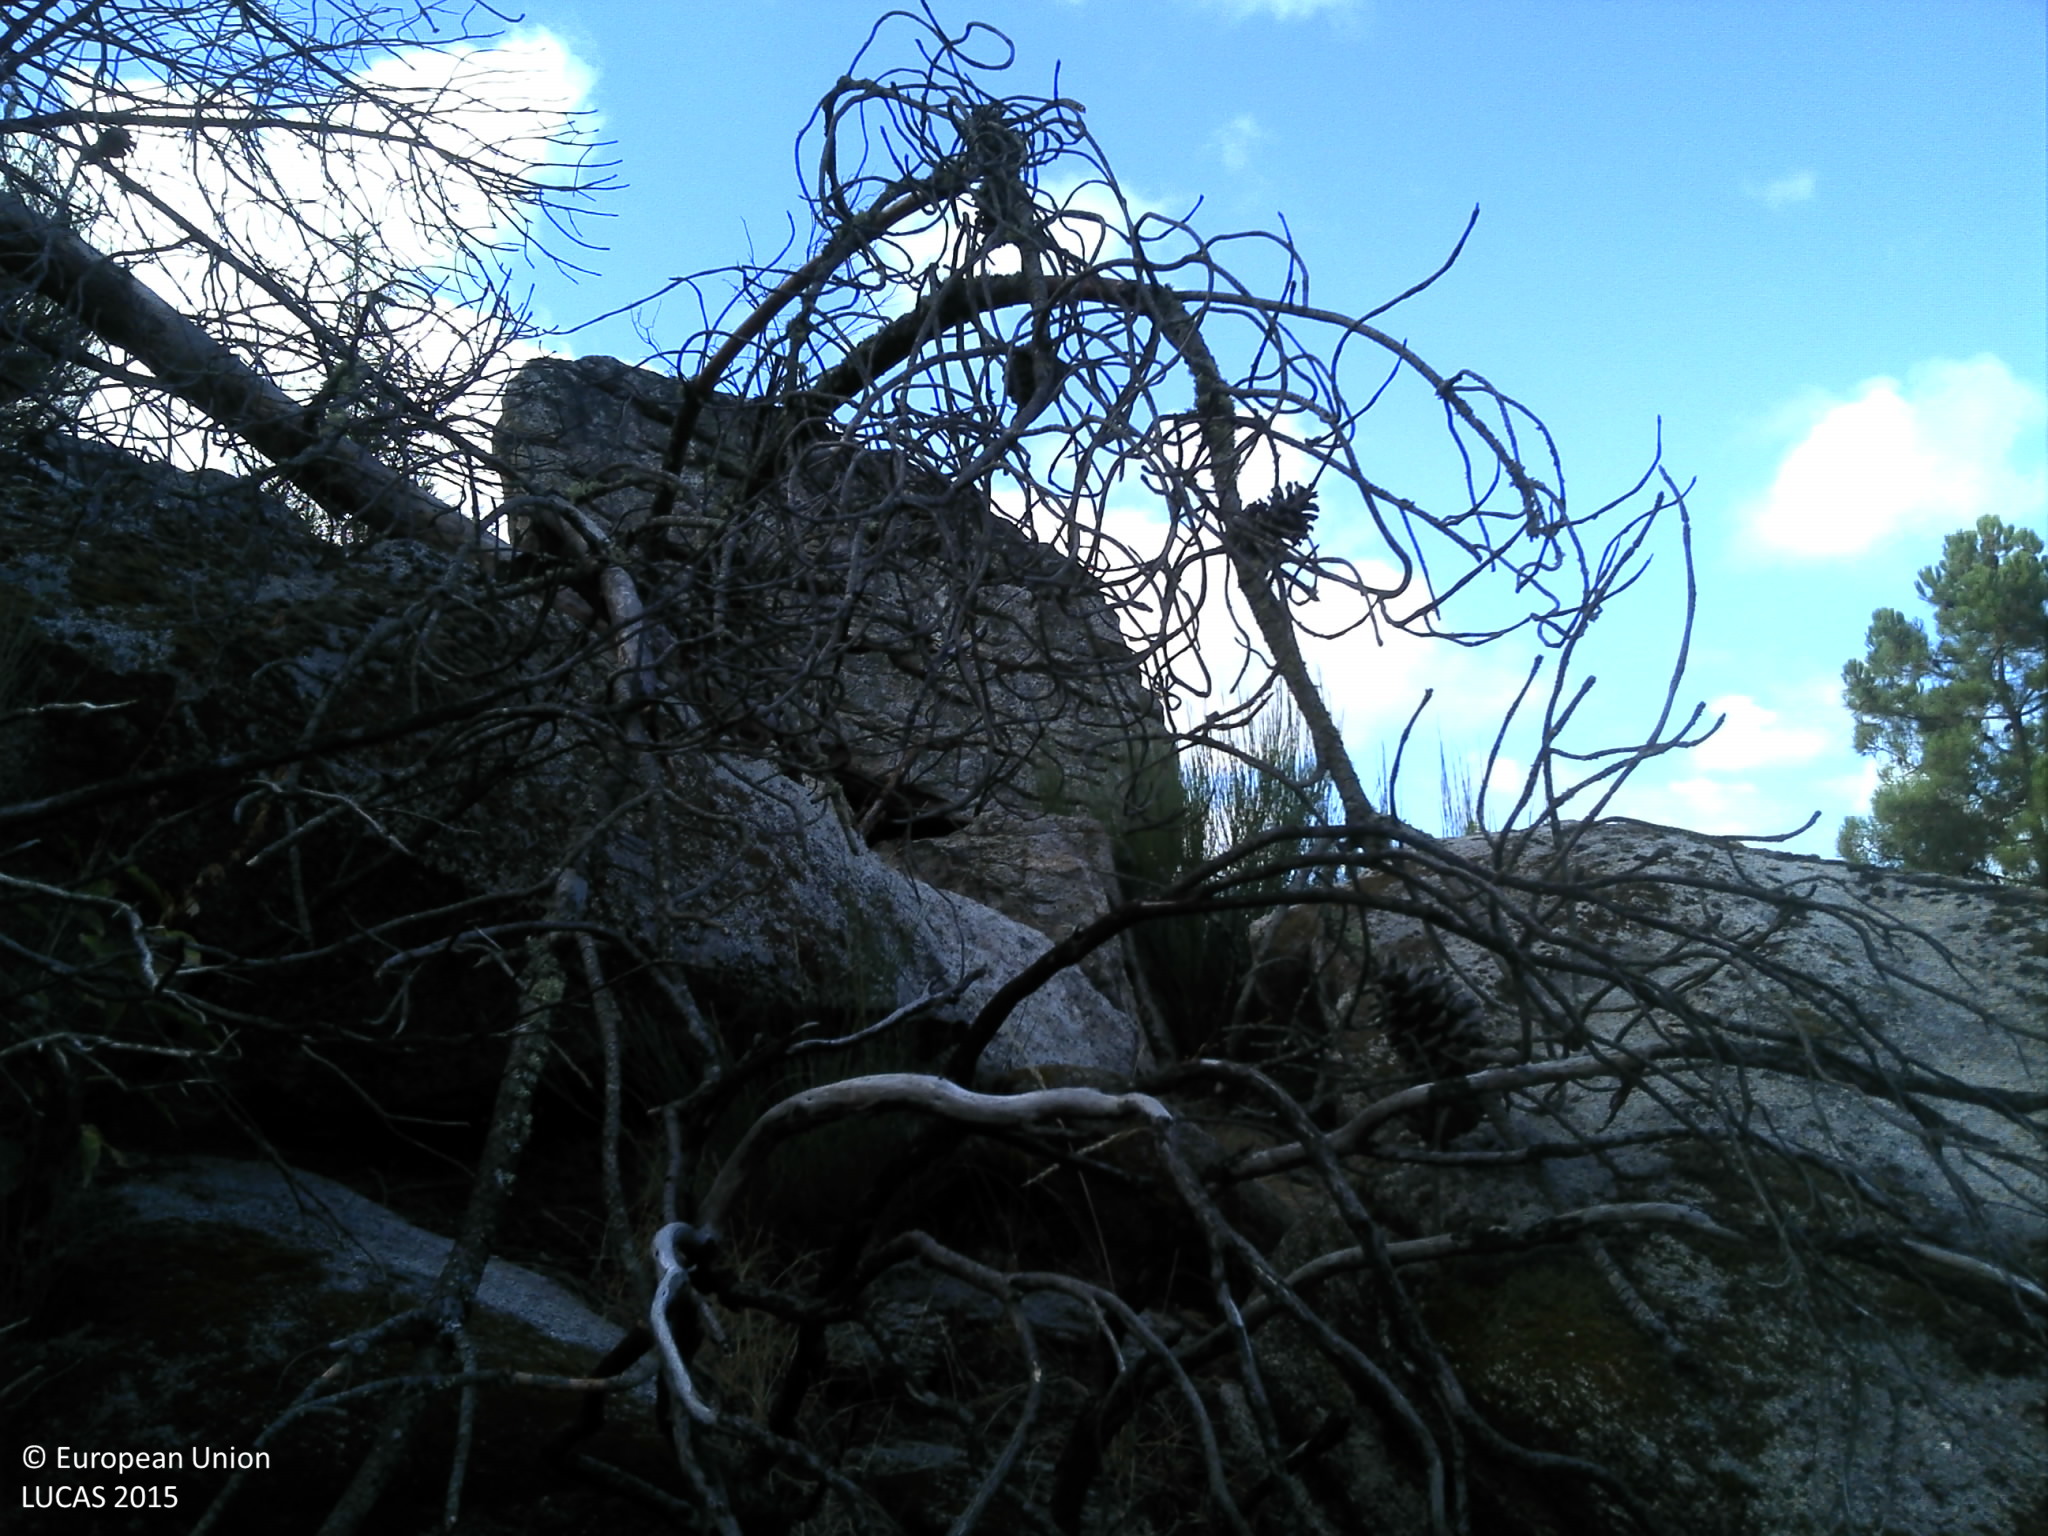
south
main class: Shrubland
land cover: Shrubland with sparse tree cover
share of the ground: 25 - 50 %
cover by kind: shrubs 45 %, herbaceous plants 25 %, consolidated bare surface 20 %, coniferous forest trees 5 %, unconsolidated bare surface 5 %
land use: Semi-natural and natural areas not in use
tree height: > 5 m
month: July
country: PT
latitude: 41.2780
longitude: -7.4210
